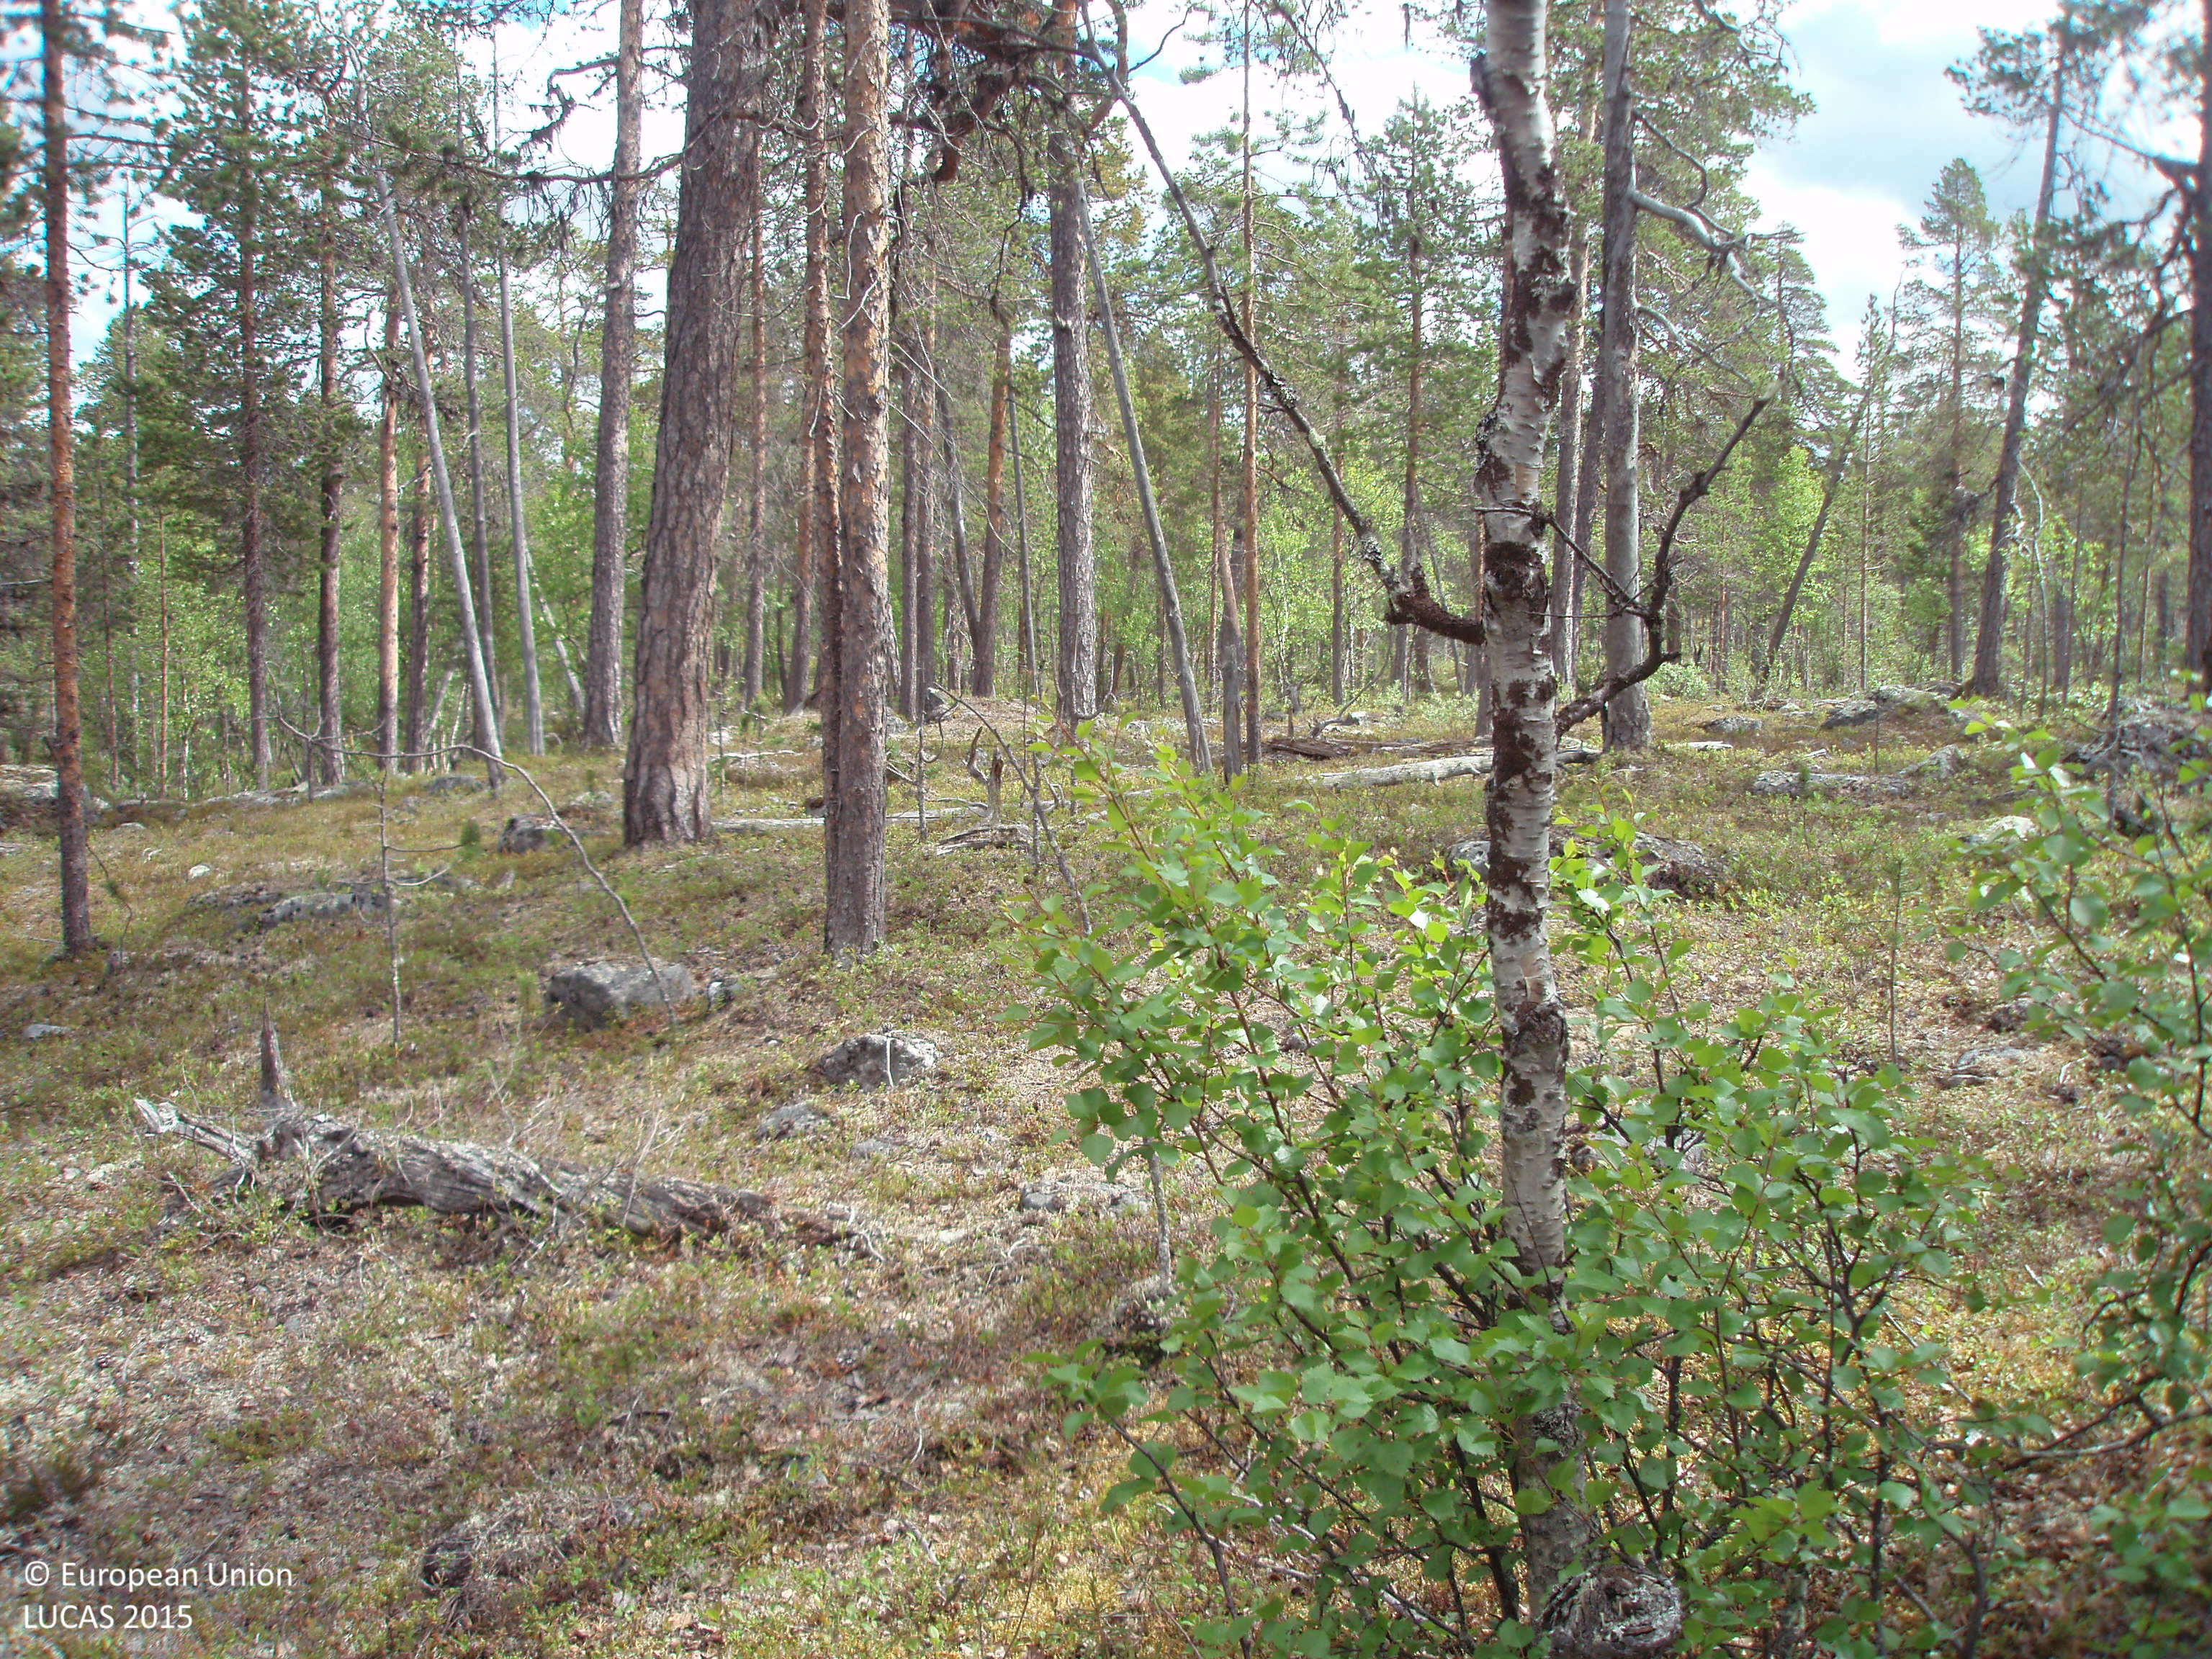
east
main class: Woodland
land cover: Pine dominated coniferous woodland
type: boreal forest
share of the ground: 50 - 75 %
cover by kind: coniferous forest trees 50 %, shrubs 35 %, broadleaved forest trees 5 %, lichens and mosses 5 %, unconsolidated bare surface 5 %
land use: Forestry
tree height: > 5 m
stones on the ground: > 50 %
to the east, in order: Pine dominated coniferous woodland; Pine dominated mixed woodland; Pine dominated coniferous woodland
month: July
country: FI
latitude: 68.8866
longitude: 25.8292
